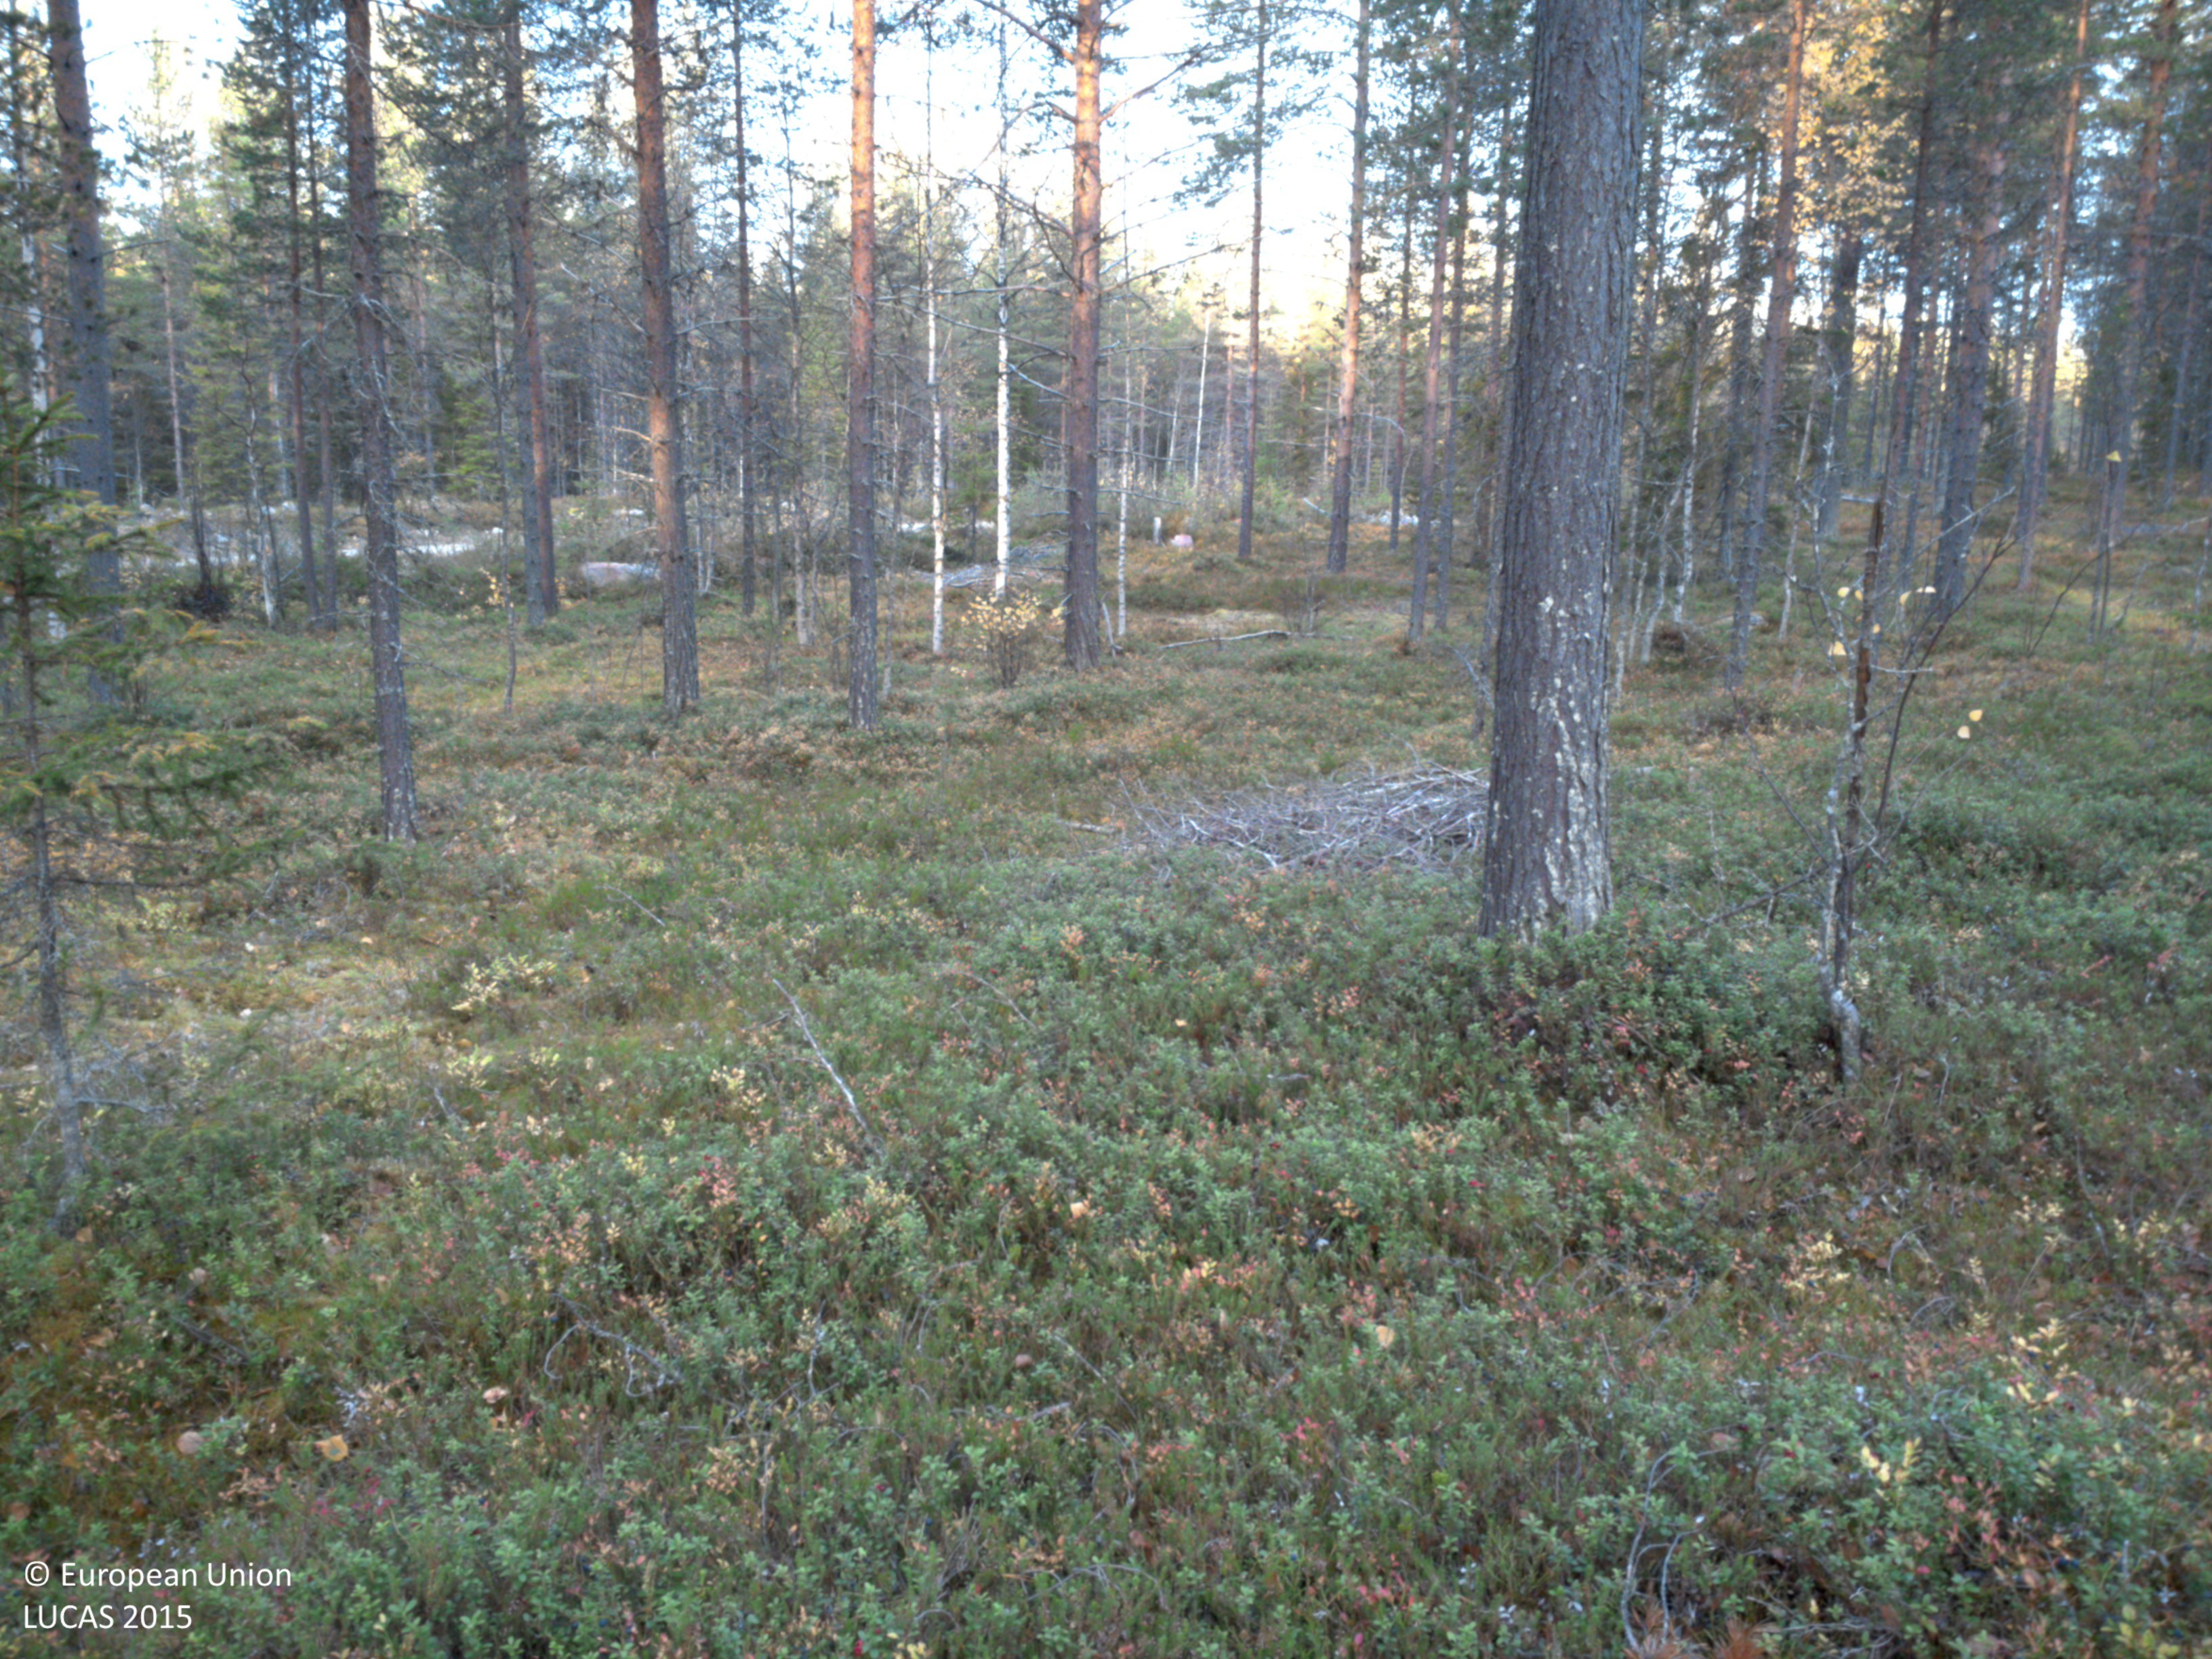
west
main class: Woodland
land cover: Pine dominated coniferous woodland
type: boreal forest
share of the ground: 50 - 75 %
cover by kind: coniferous forest trees 75 %, shrubs 15 %, lichens and mosses 10 %
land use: Forestry
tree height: > 5 m
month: October
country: SE
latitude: 64.9631
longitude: 18.2870
